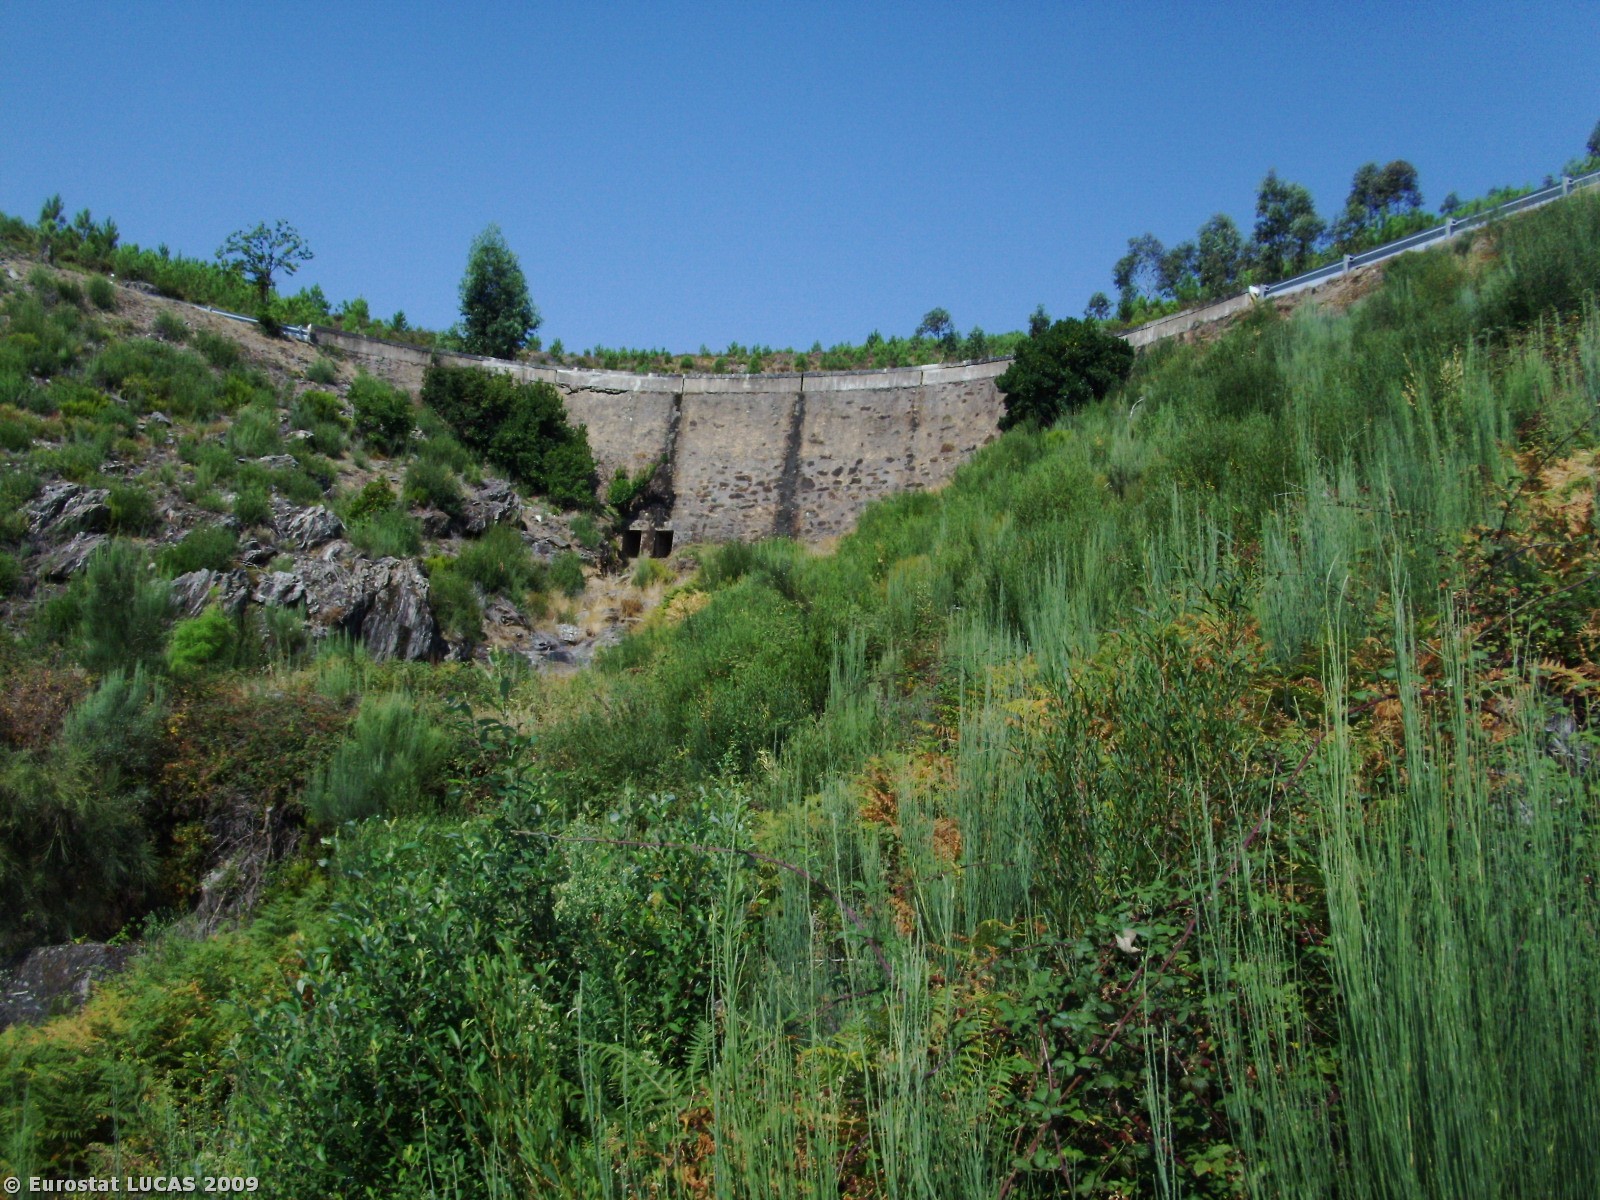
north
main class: Shrubland
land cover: Shrubland without tree cover
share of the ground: > 75 %
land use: Forestry
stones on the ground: > 50 %
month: August
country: PT
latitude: 40.2389
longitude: -7.6597
